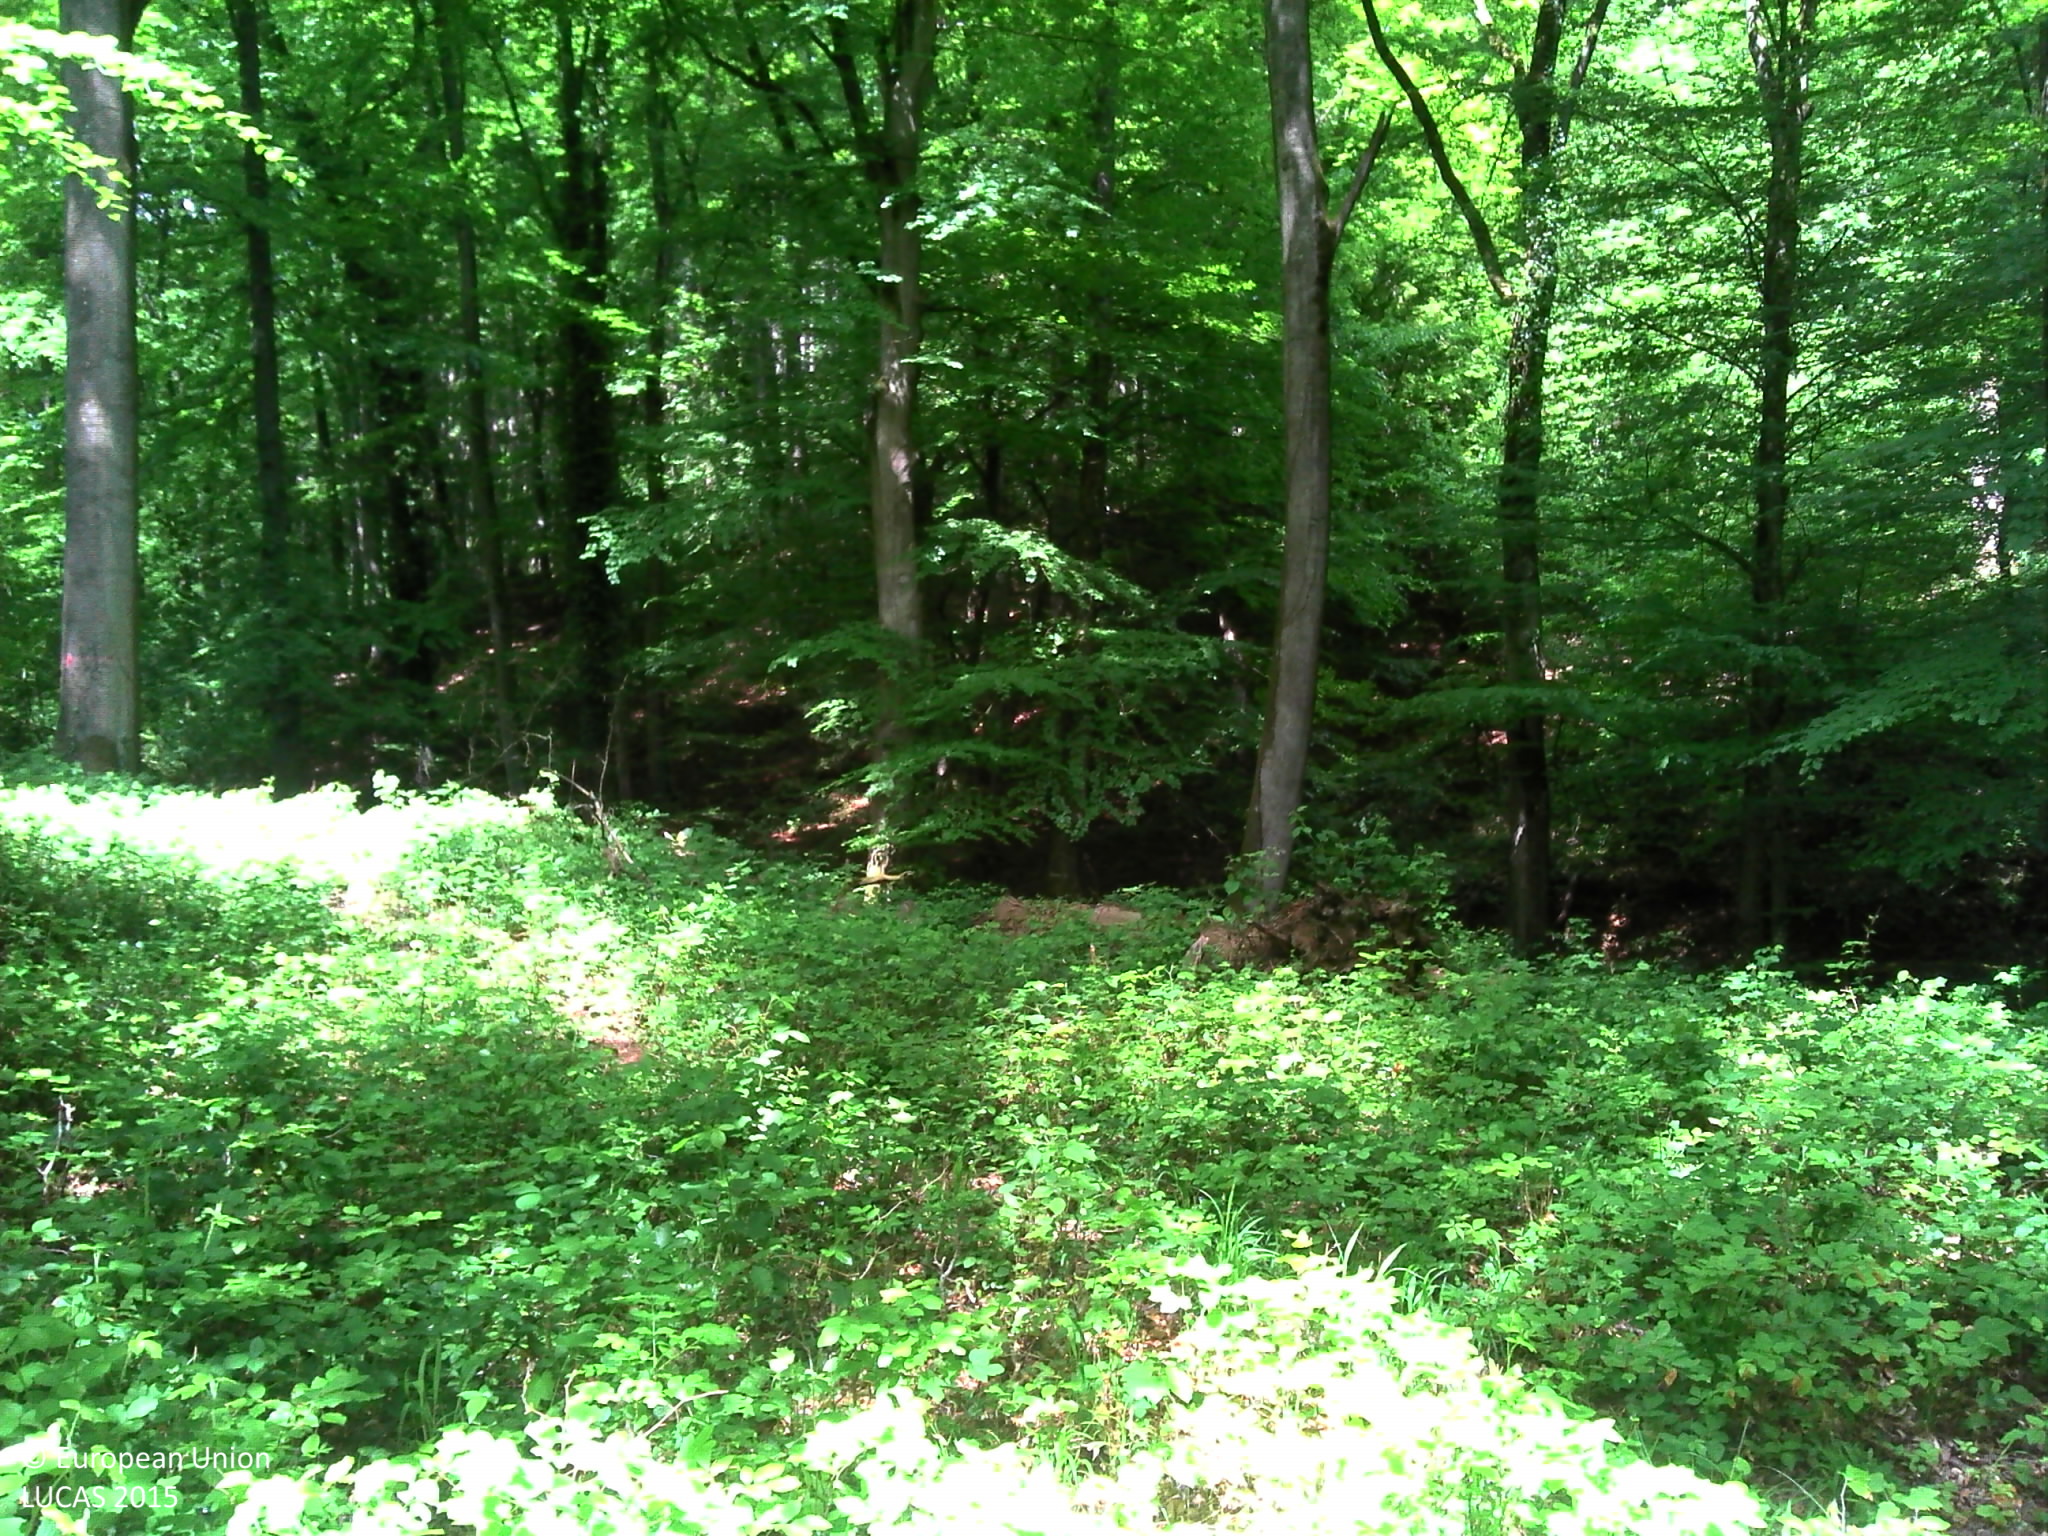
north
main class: Woodland
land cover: Broadleaved woodland
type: acidophilous oak and oak-birch forest
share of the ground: > 75 %
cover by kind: broadleaved forest trees 95 %, herbaceous plants 5 %
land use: Forestry
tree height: > 5 m
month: May
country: LU
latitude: 49.7334
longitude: 6.4618
